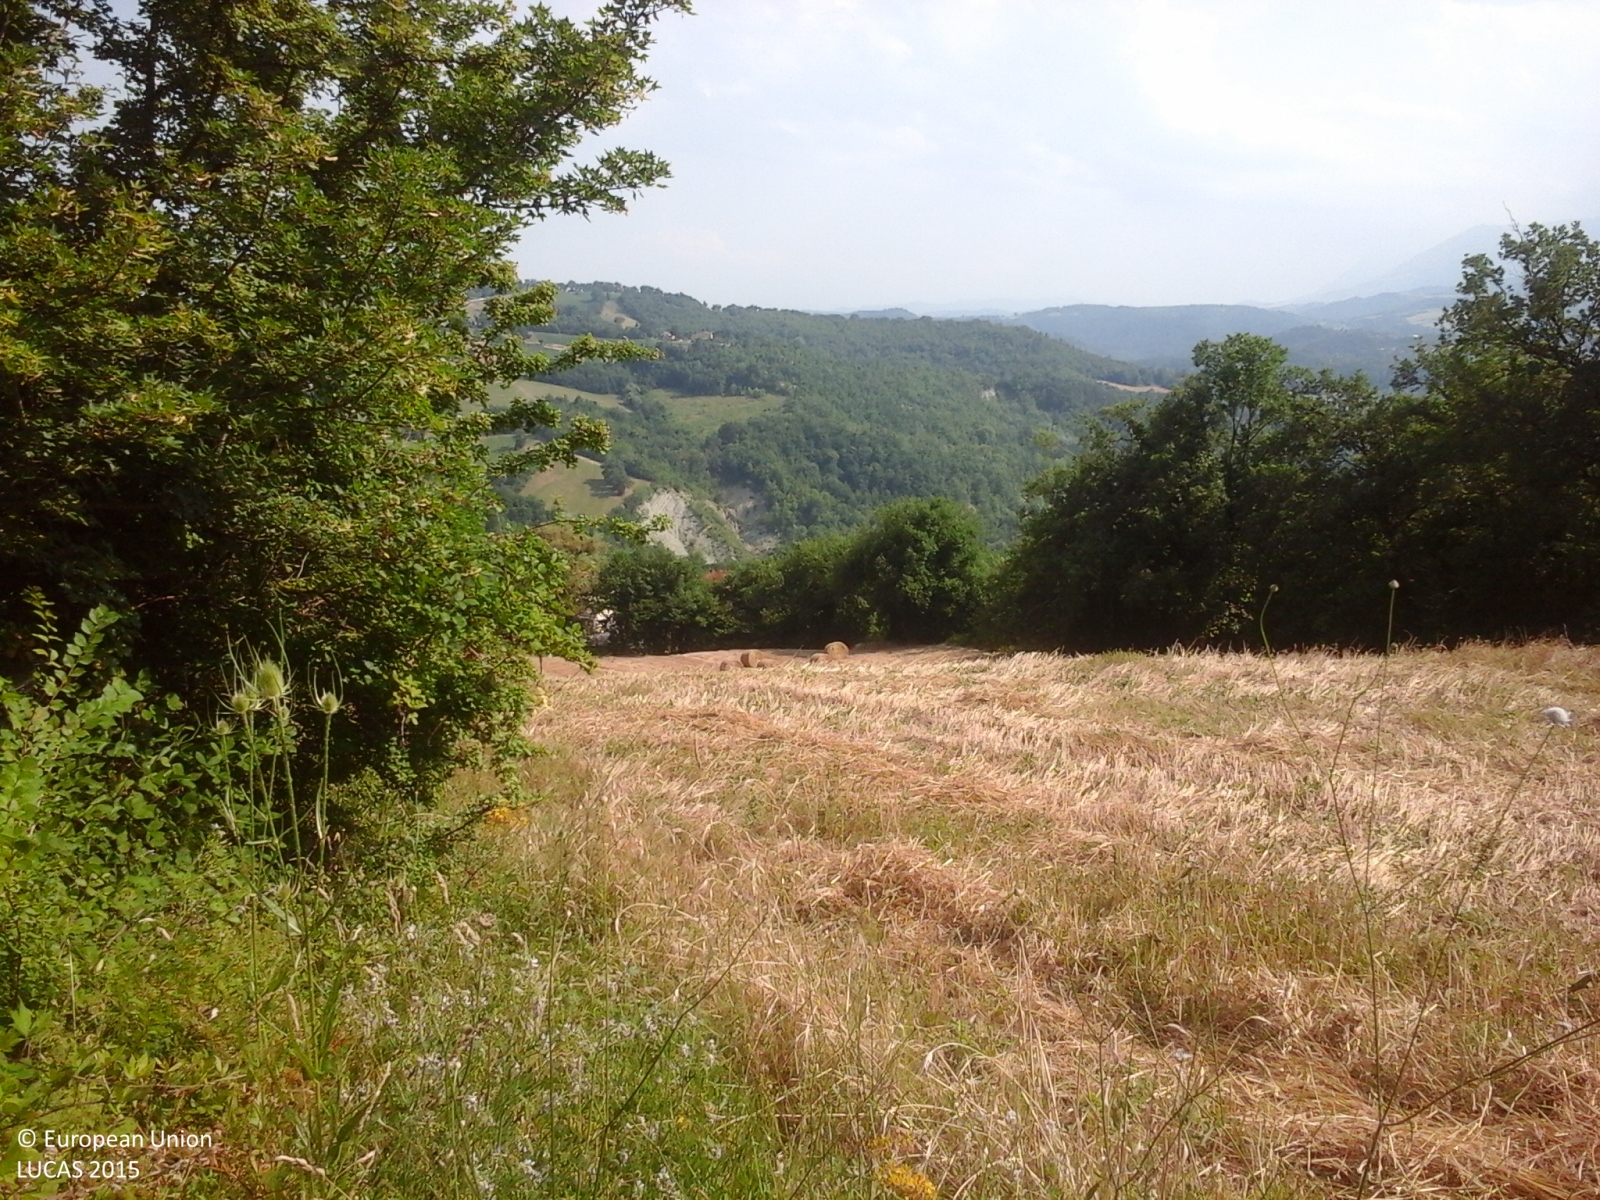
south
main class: Shrubland
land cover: Shrubland without tree cover
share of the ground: > 75 %
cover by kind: shrubs 95 %, herbaceous plants 5 %
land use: Semi-natural and natural areas not in use
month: July
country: IT
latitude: 43.0515
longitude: 13.3179
